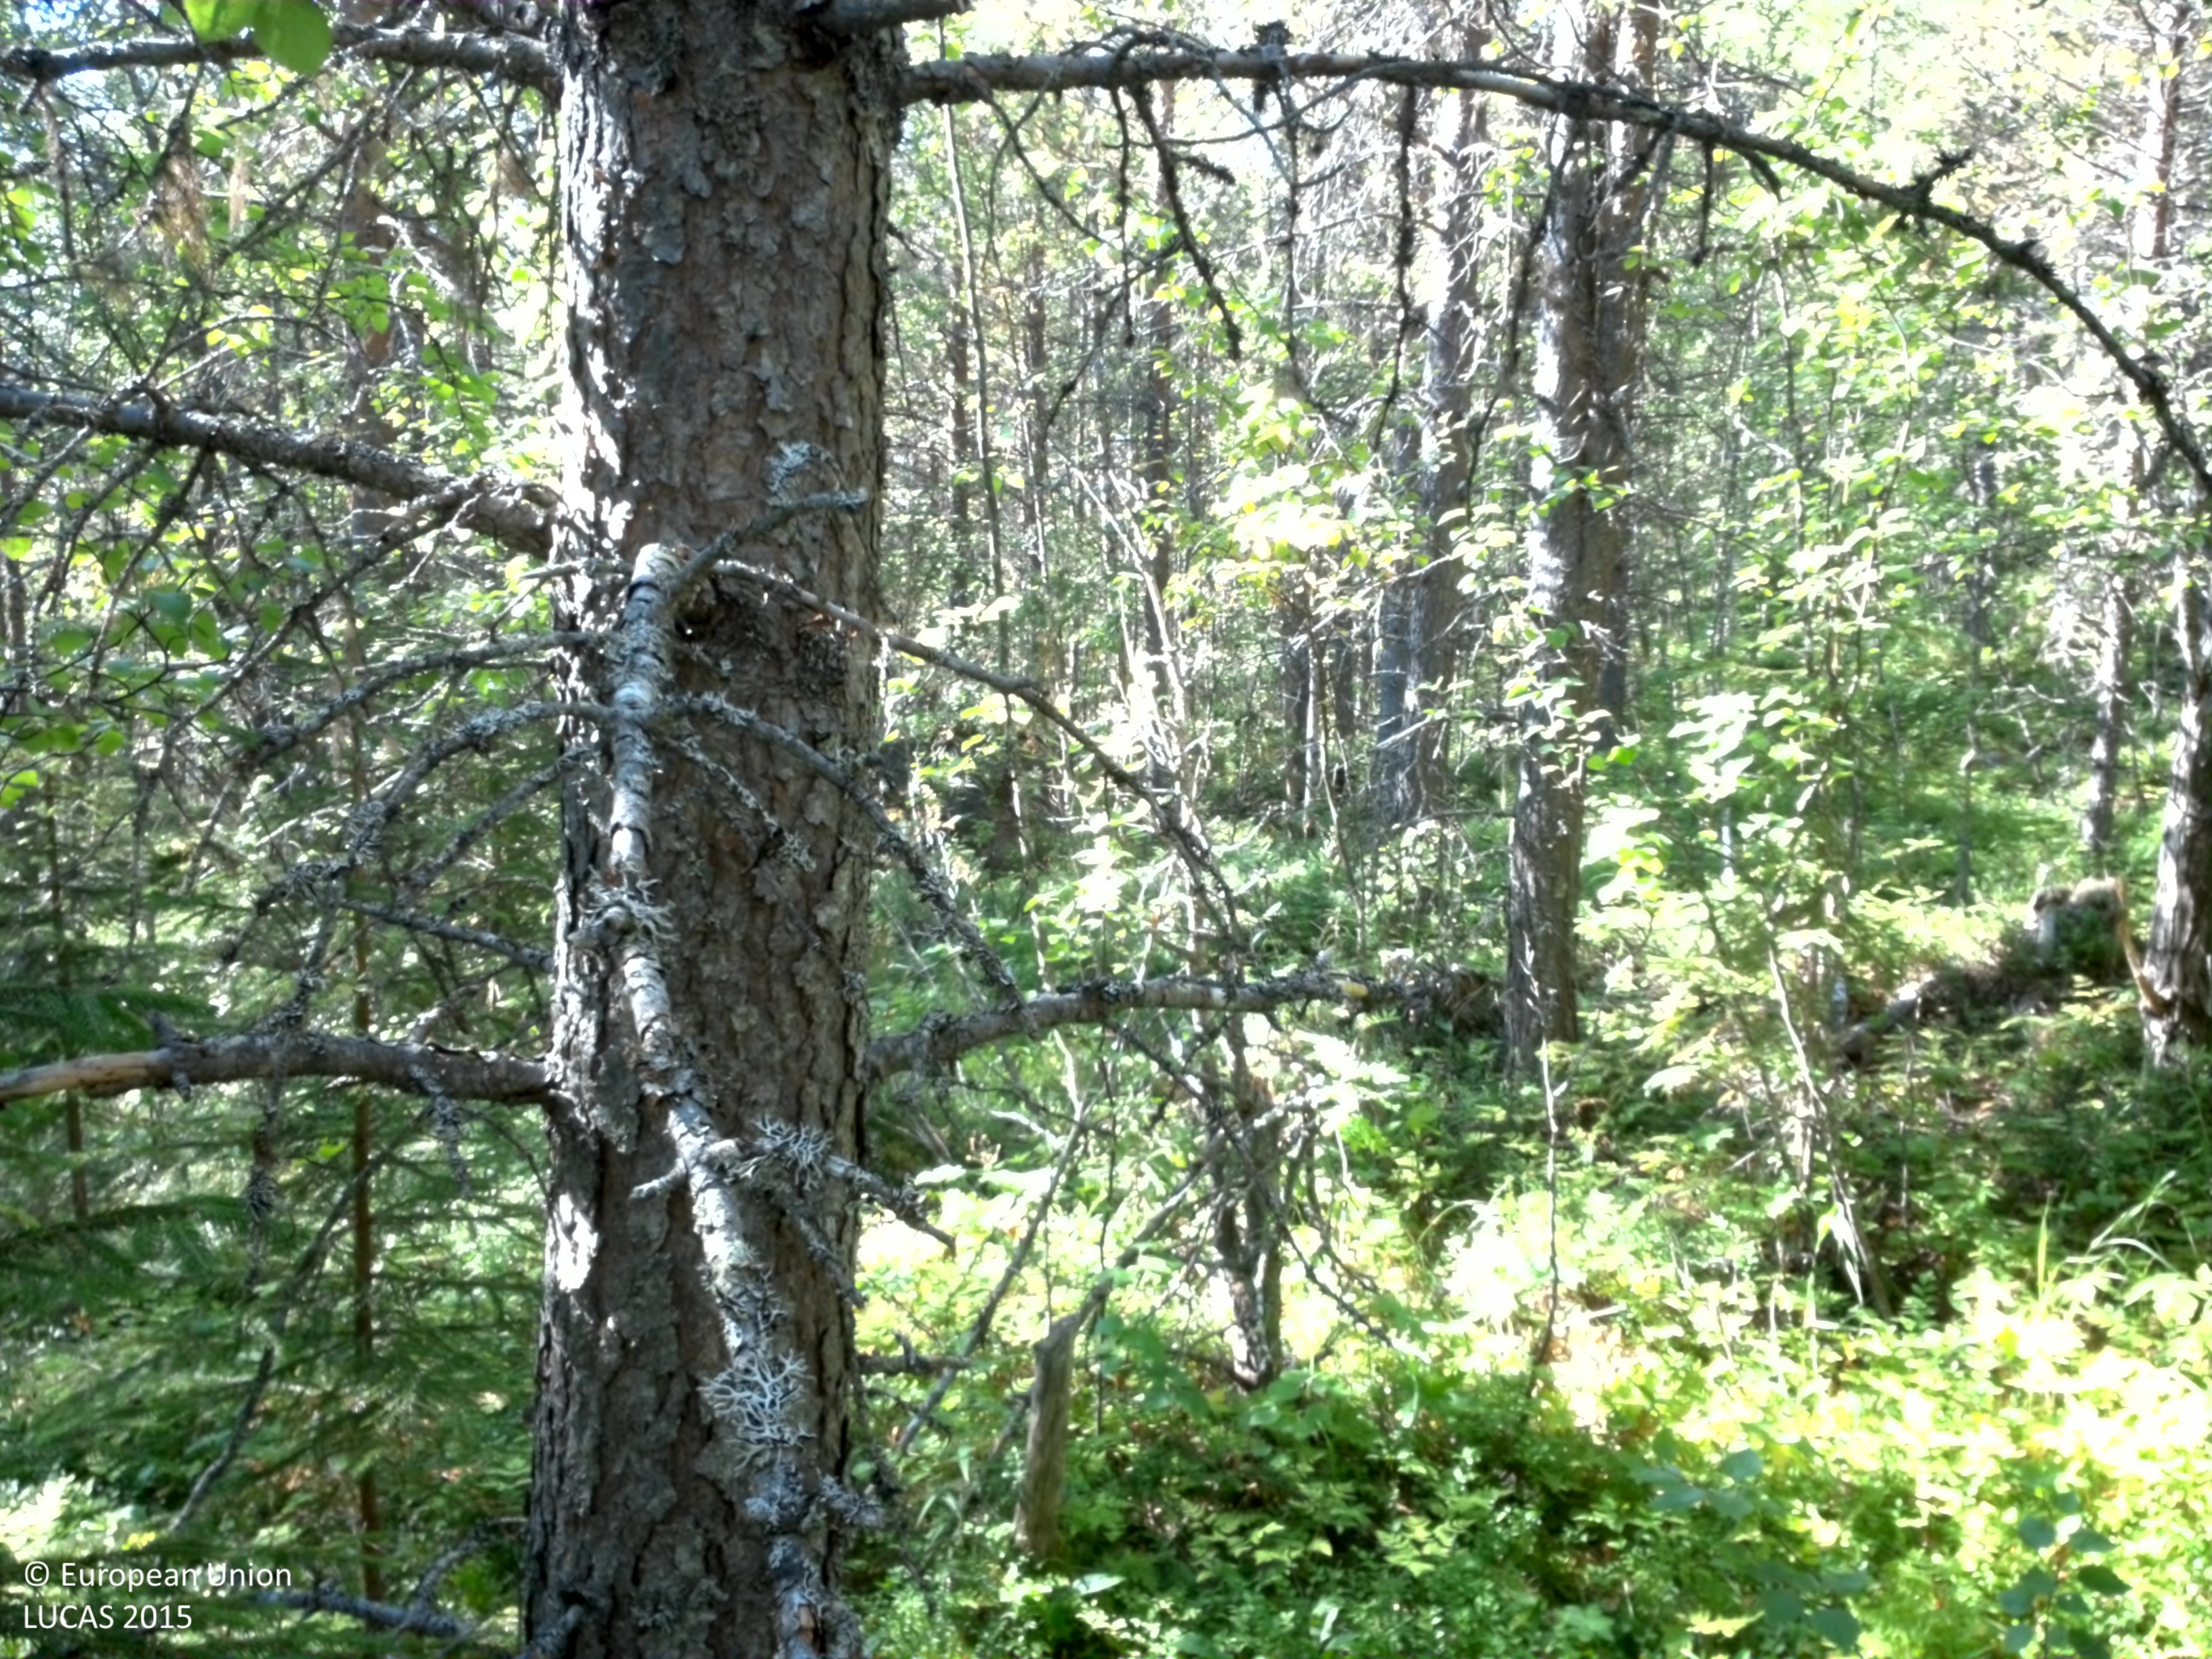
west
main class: Woodland
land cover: Pine dominated mixed woodland
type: boreal forest
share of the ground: 50 - 75 %
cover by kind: coniferous forest trees 35 %, broadleaved forest trees 30 %, shrubs 25 %, herbaceous plants 10 %
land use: Forestry
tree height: > 5 m
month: August
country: SE
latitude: 64.6740
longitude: 16.6920
